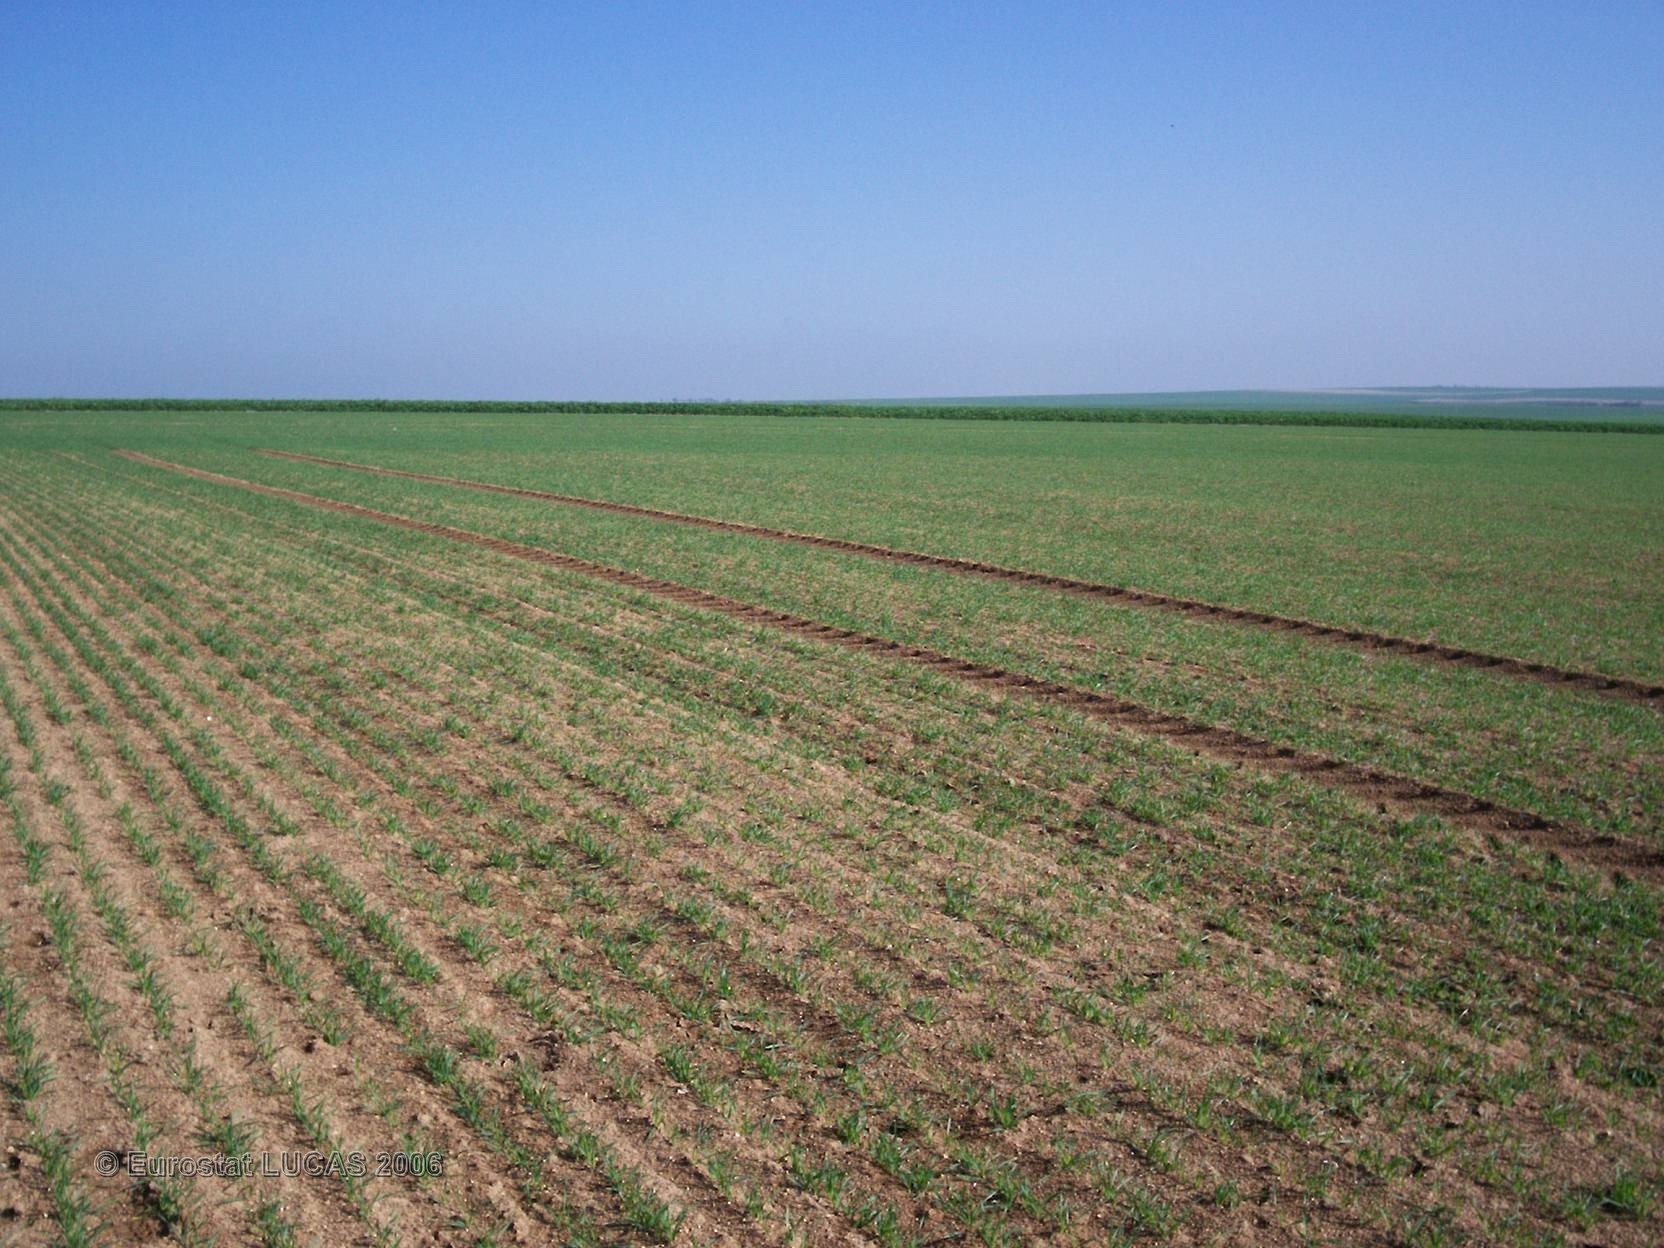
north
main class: Cropland
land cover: Barley
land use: Agriculture (excluding fallow land and kitchen gardens)
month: April
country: FR
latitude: 48.5337
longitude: 4.4310
